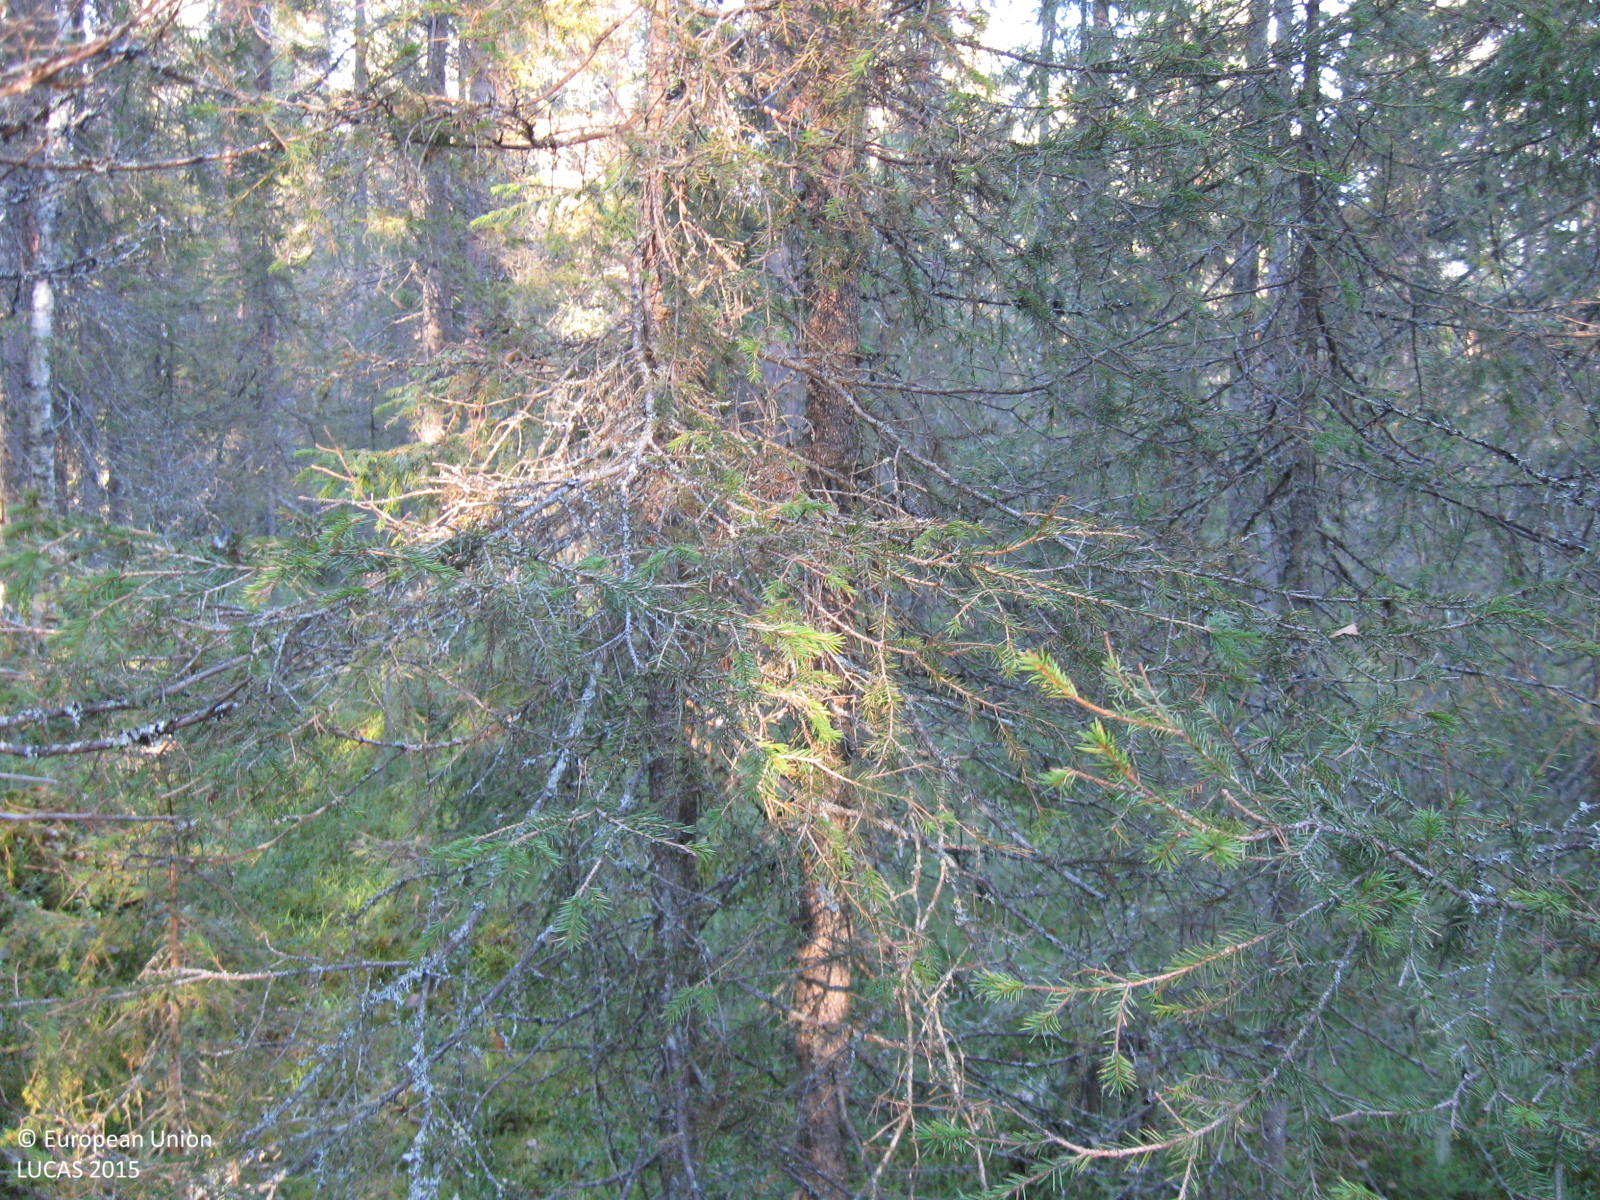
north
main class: Woodland
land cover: Other coniferous woodland
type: boreal forest
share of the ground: > 75 %
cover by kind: coniferous forest trees 80 %, broadleaved forest trees 5 %, shrubs 5 %, herbaceous plants 5 %, lichens and mosses 5 %
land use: Forestry
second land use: Amenities, museums, leisure
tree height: > 5 m
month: November
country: SE
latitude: 66.1340
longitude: 20.7485
